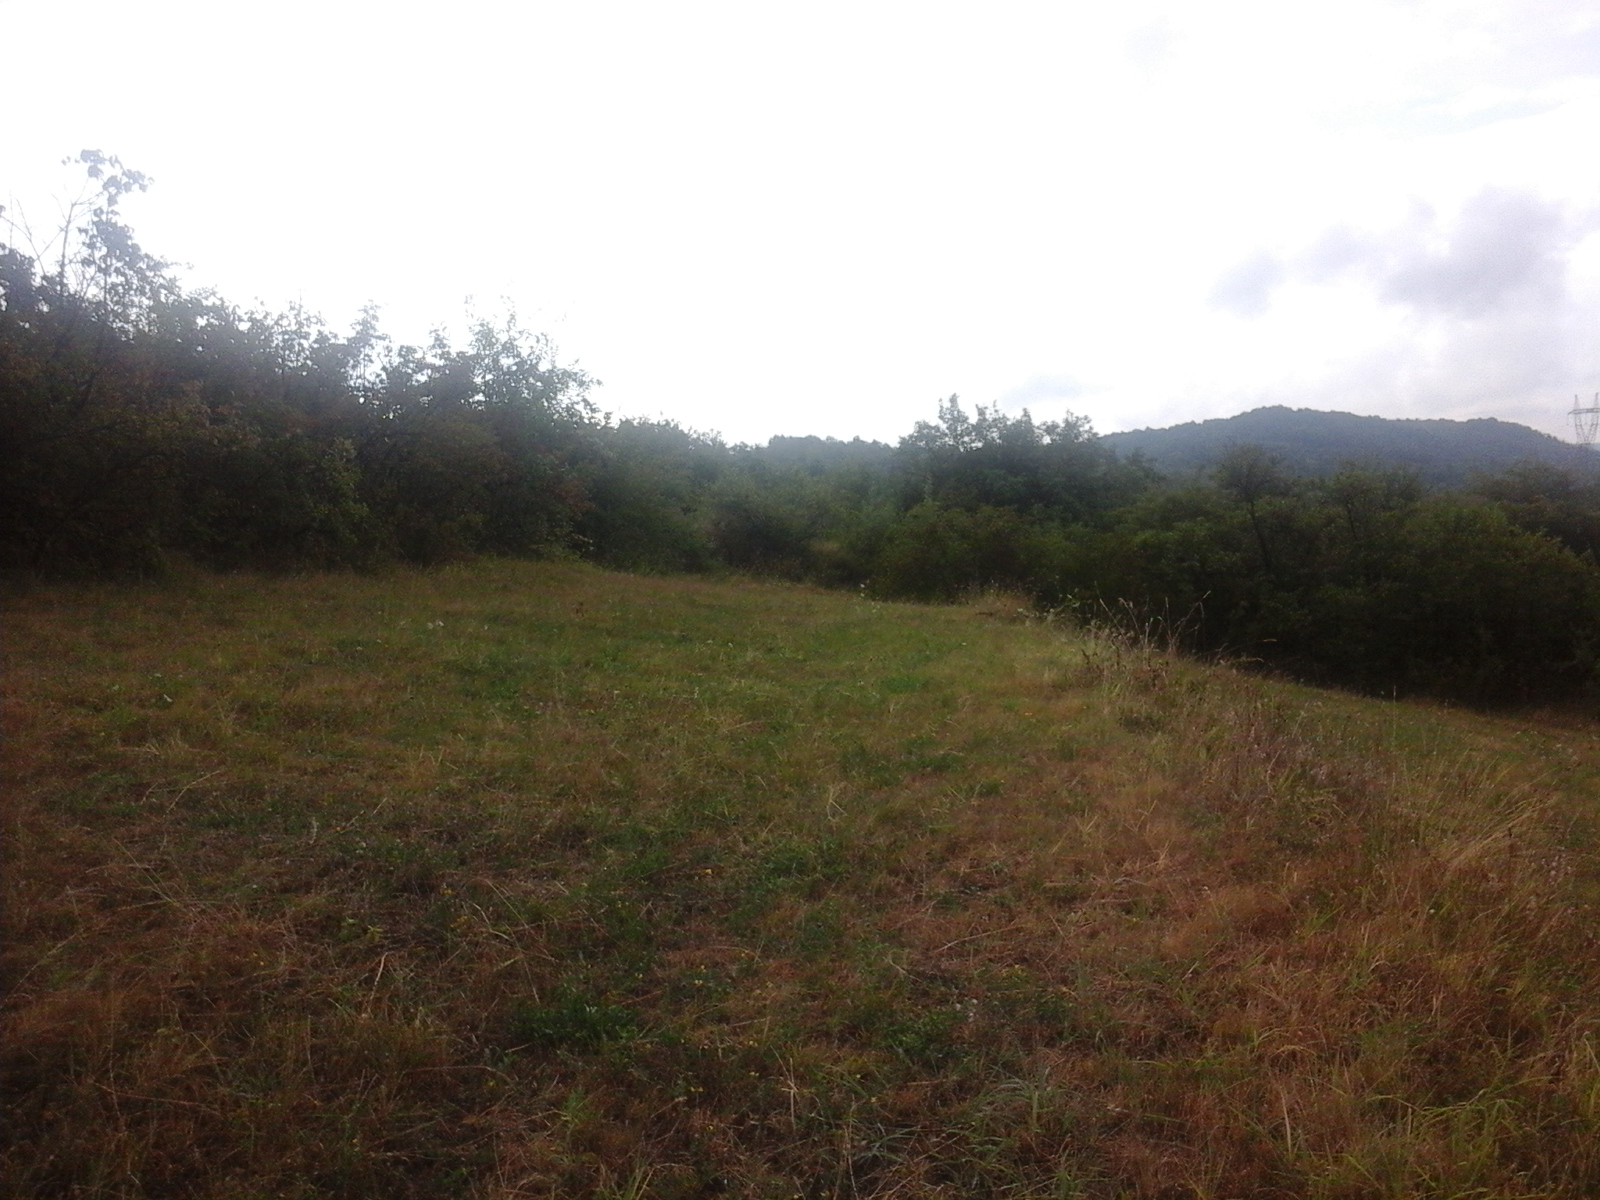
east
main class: Grassland
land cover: Grassland with sparse tree/shrub cover
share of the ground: > 75 %
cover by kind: herbaceous plants 95 %, broadleaved forest trees 5 %
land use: Agriculture (excluding fallow land and kitchen gardens)
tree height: < 5 m
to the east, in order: Grassland with sparse tree/shrub cover; Abandoned hedges; Tracks; Grassland with sparse tree/shrub cover; Tracks; Grassland with sparse tree/shrub cover; Apple fruit
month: August
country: RO
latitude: 44.8863
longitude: 22.7949
